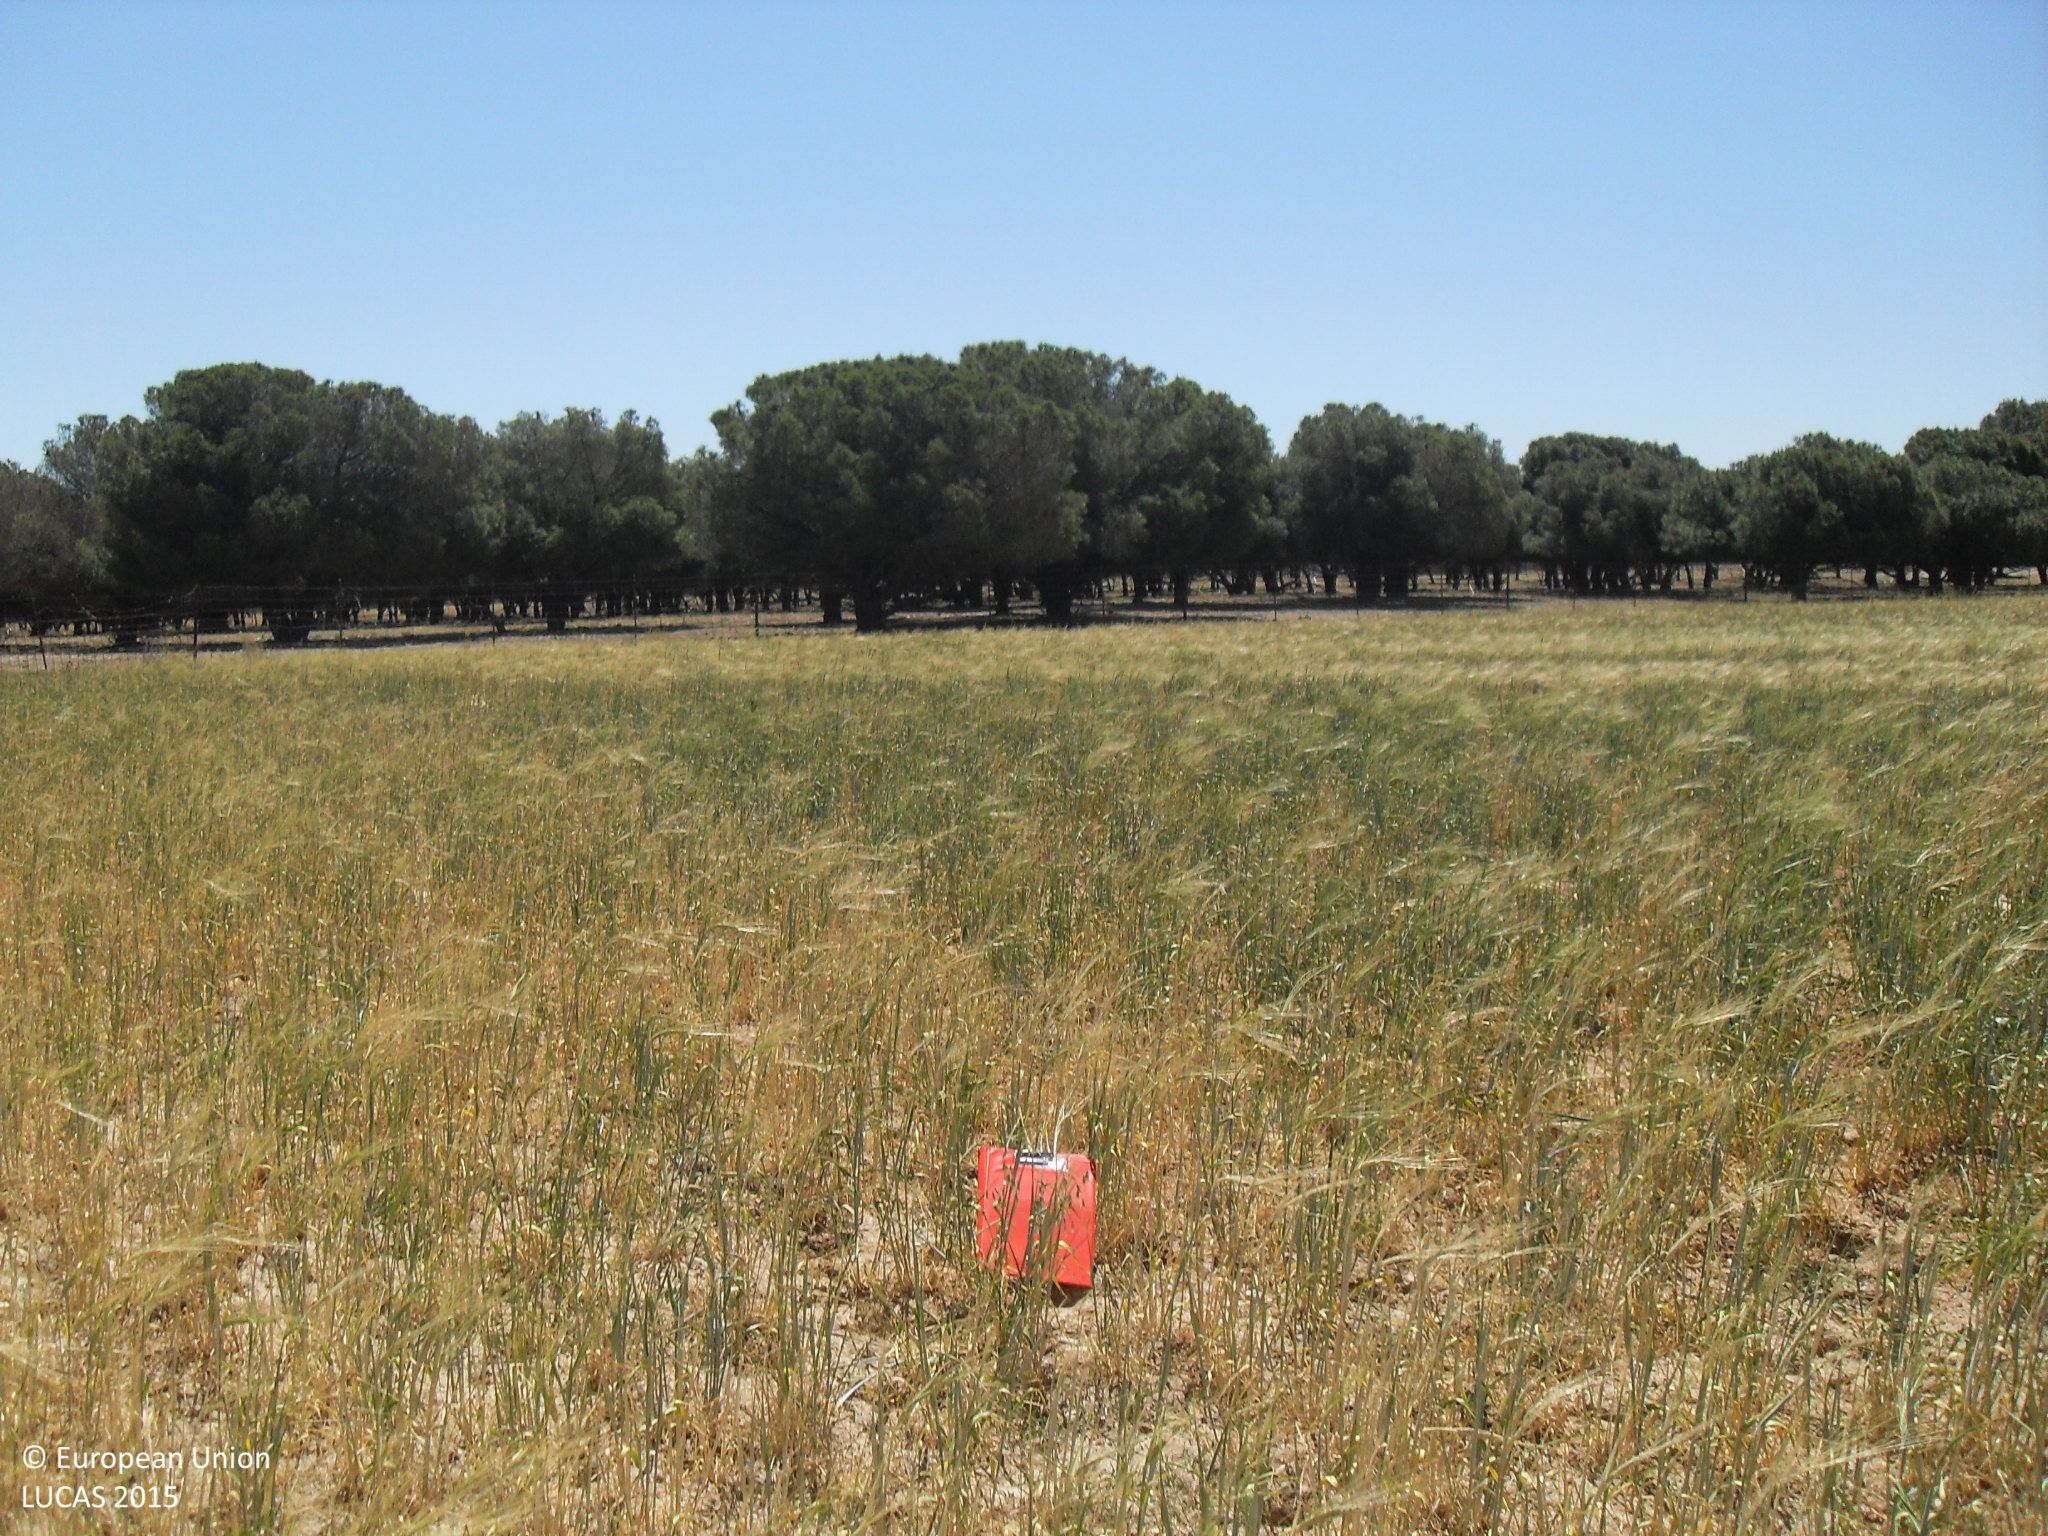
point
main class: Cropland
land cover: Barley
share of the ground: > 75 %
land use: Agriculture (excluding fallow land and kitchen gardens)
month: May
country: ES
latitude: 41.1231
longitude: -5.2578
